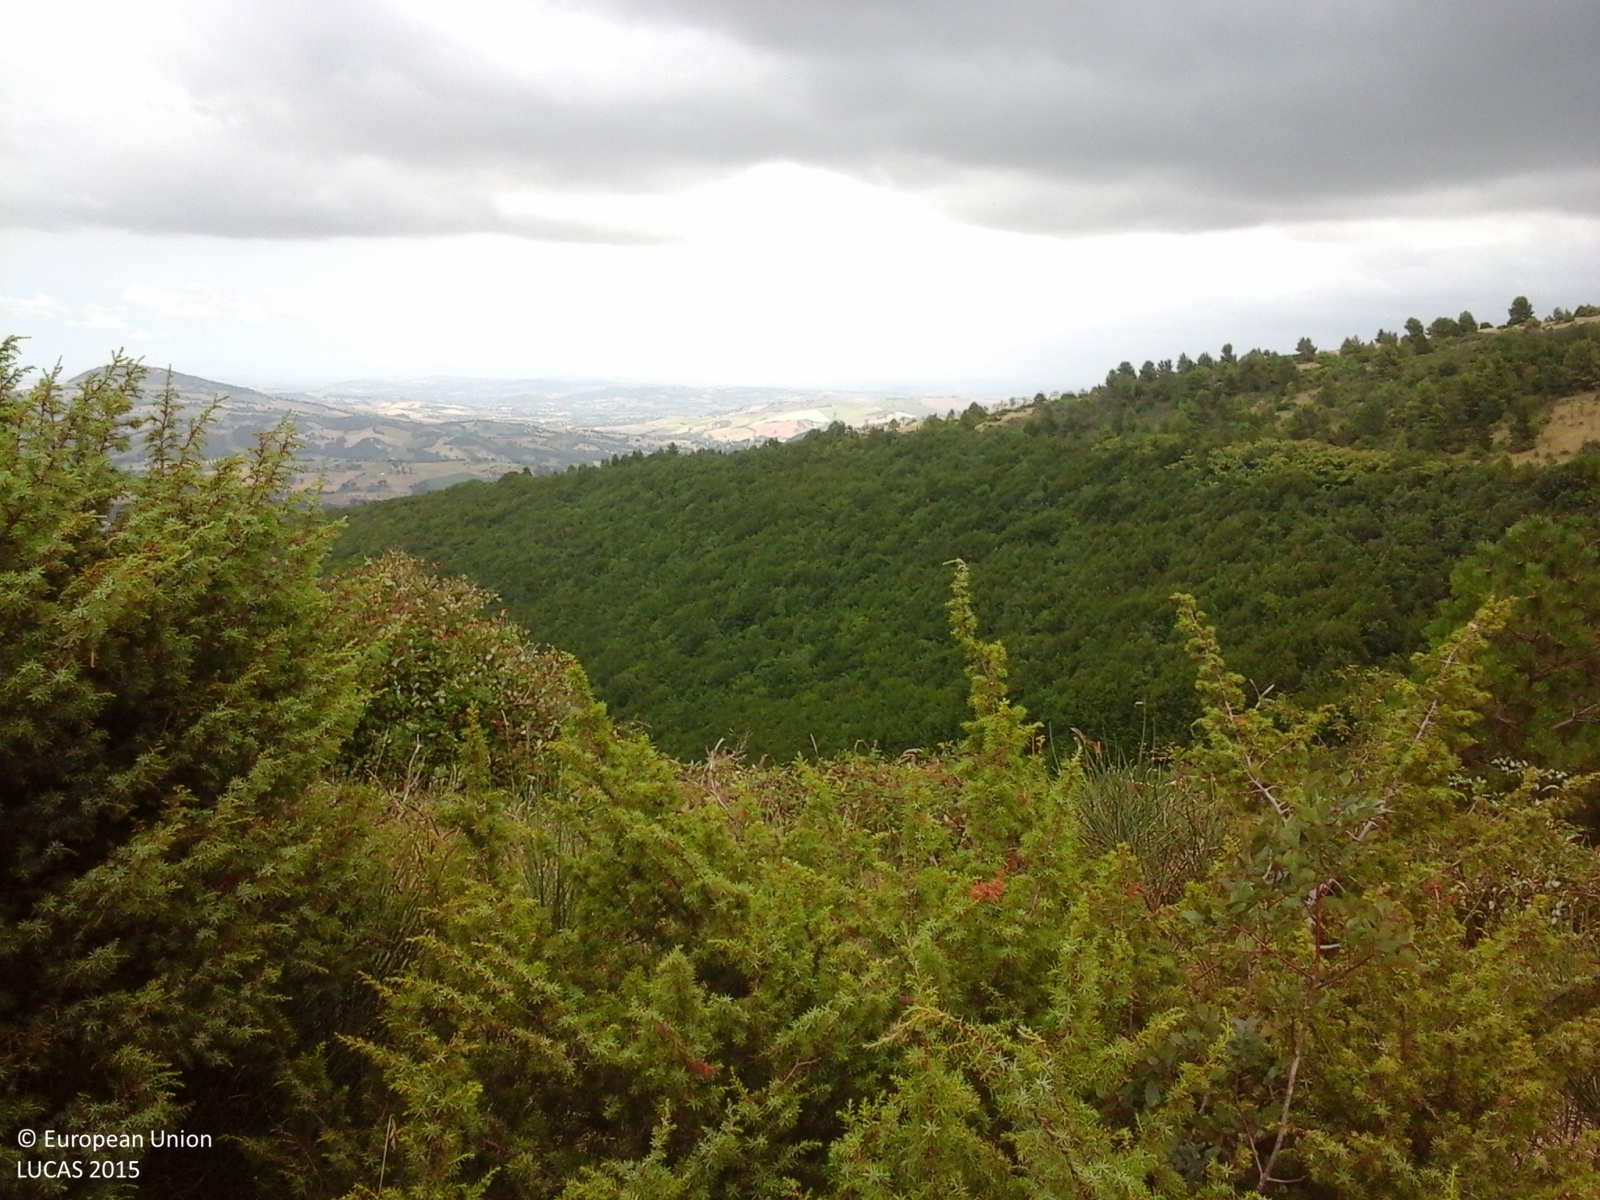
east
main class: Cropland
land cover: Triticale
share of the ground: > 75 %
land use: Agriculture (excluding fallow land and kitchen gardens)
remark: Harvested field
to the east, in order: Triticale; Abandoned hedges; Tracks; Abandoned hedges; Shrubland with sparse tree cover; Broadleaved woodland
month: July
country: IT
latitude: 43.2380
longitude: 13.1318
